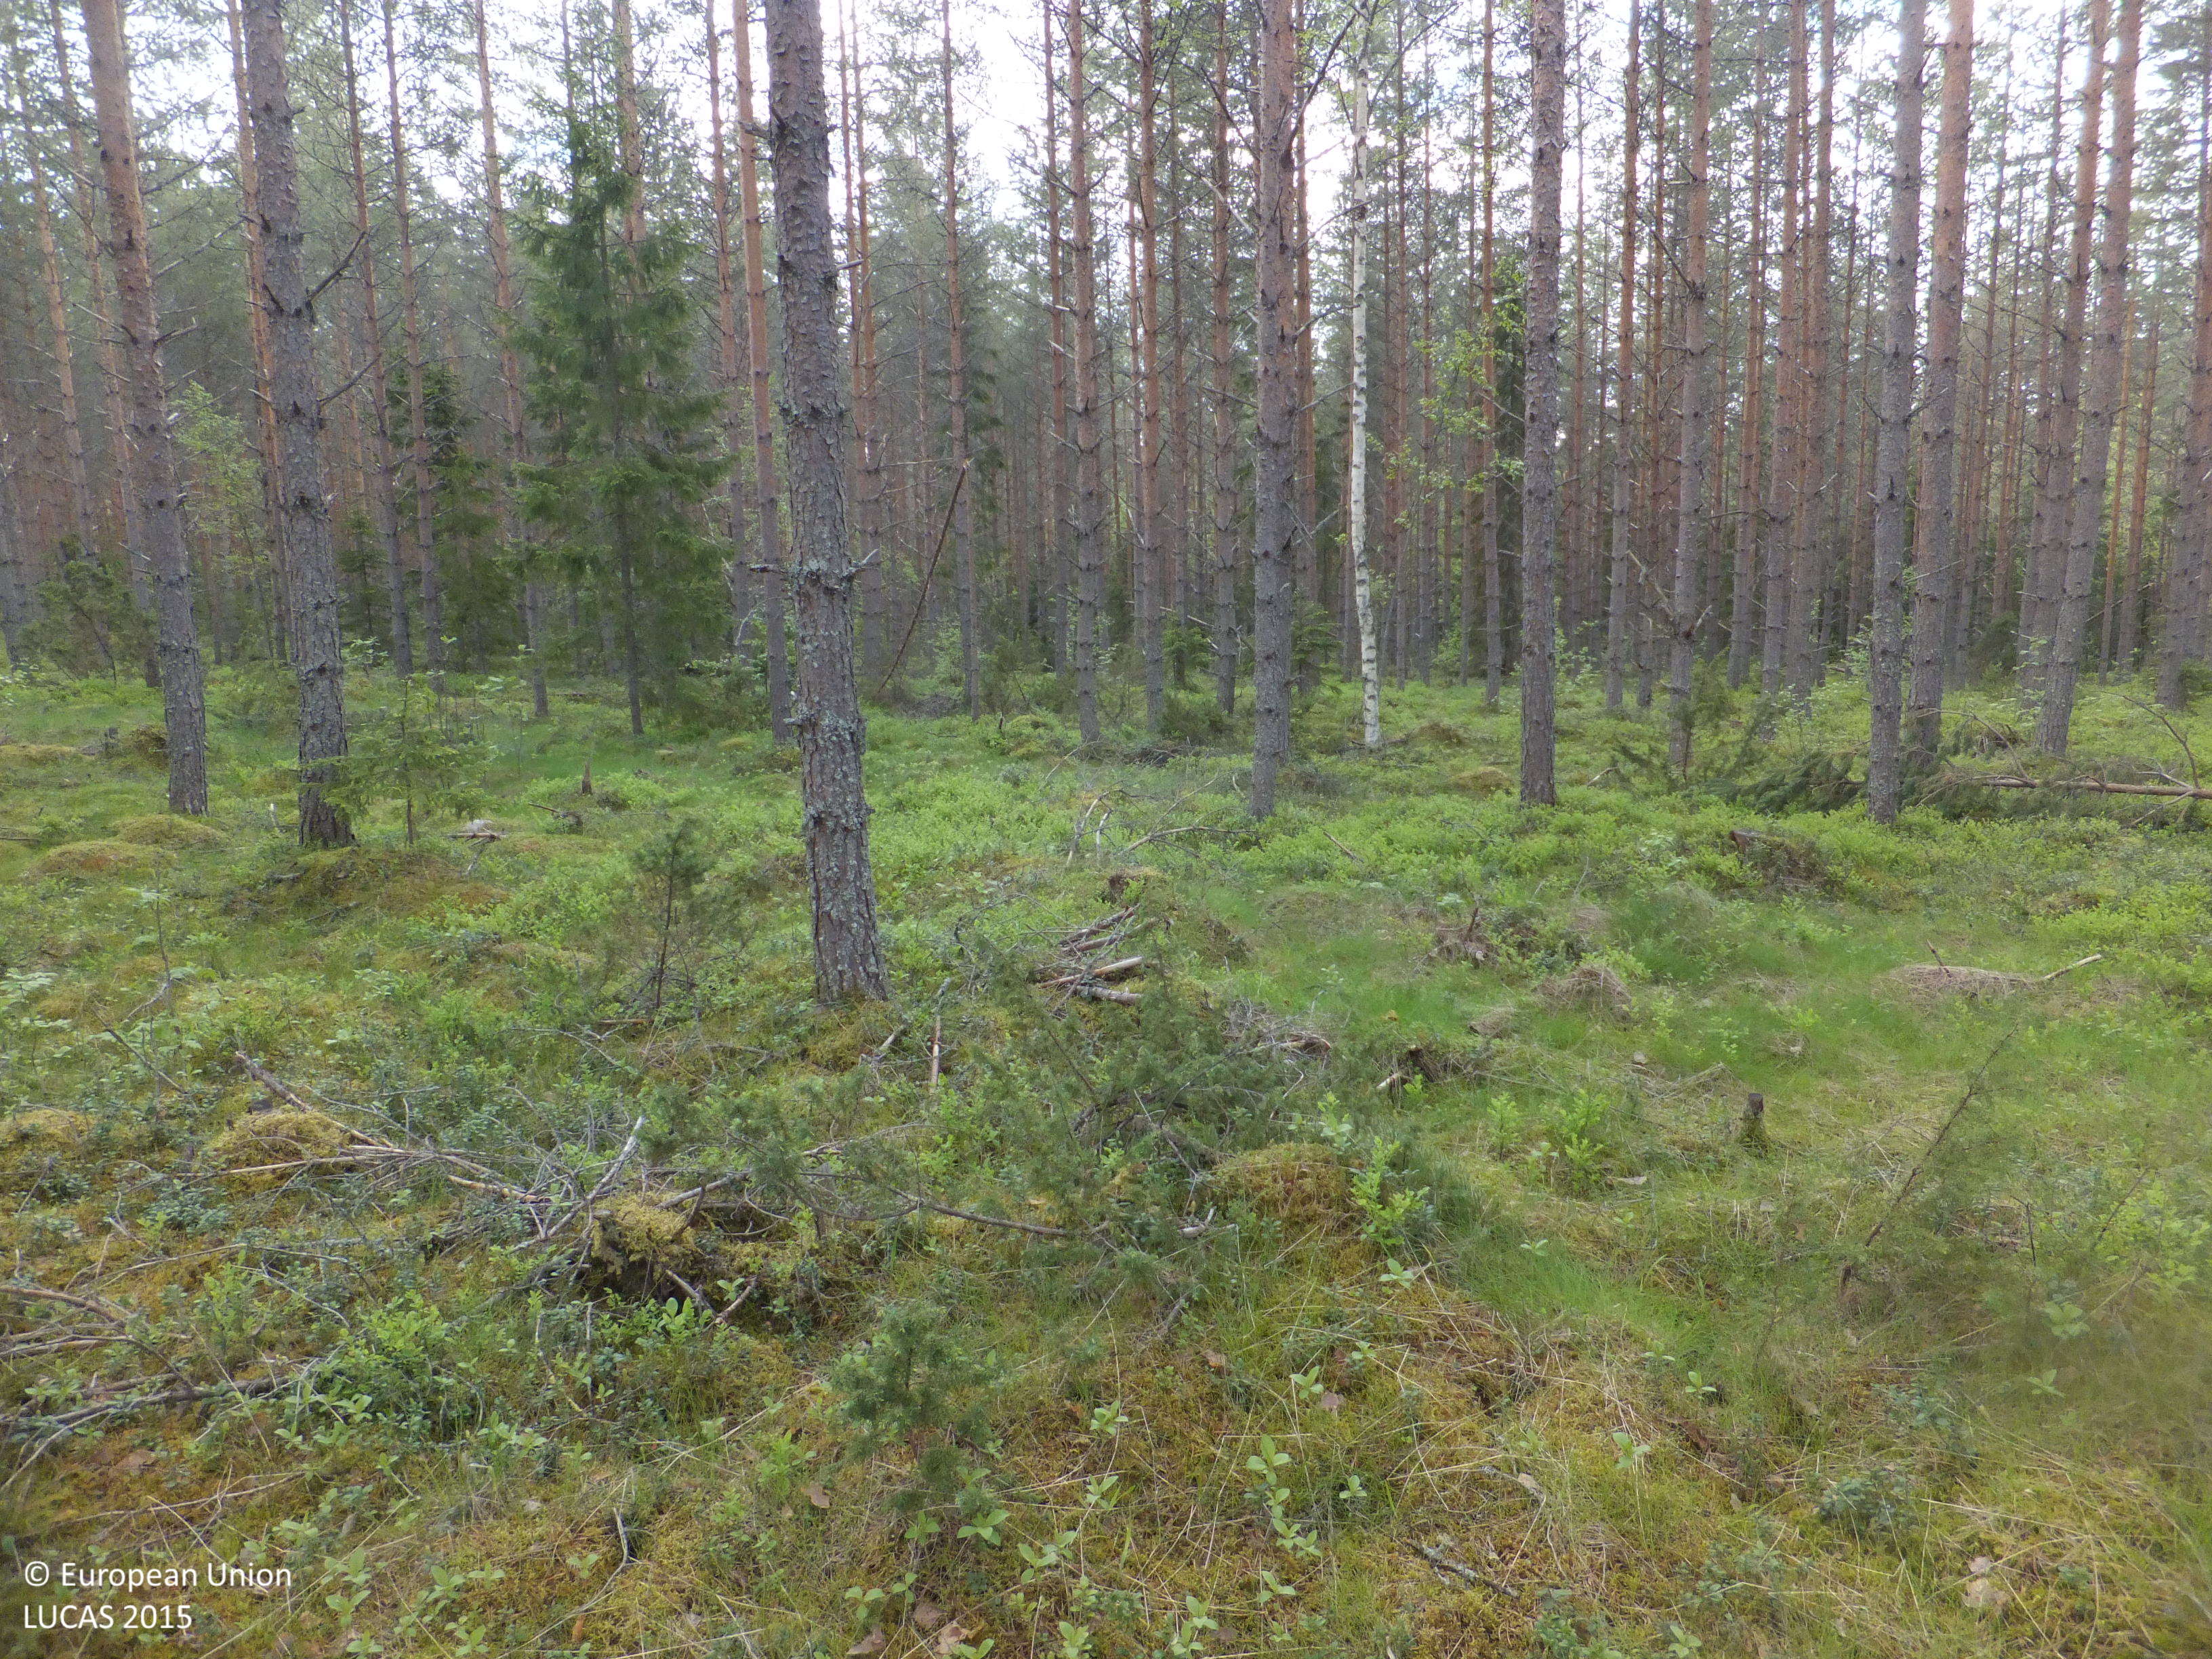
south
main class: Woodland
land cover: Pine dominated coniferous woodland
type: boreal forest
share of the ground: > 75 %
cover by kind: coniferous forest trees 90 %, shrubs 5 %, herbaceous plants 5 %
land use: Forestry
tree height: > 5 m
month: June
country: FI
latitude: 63.4941
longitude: 23.2122
